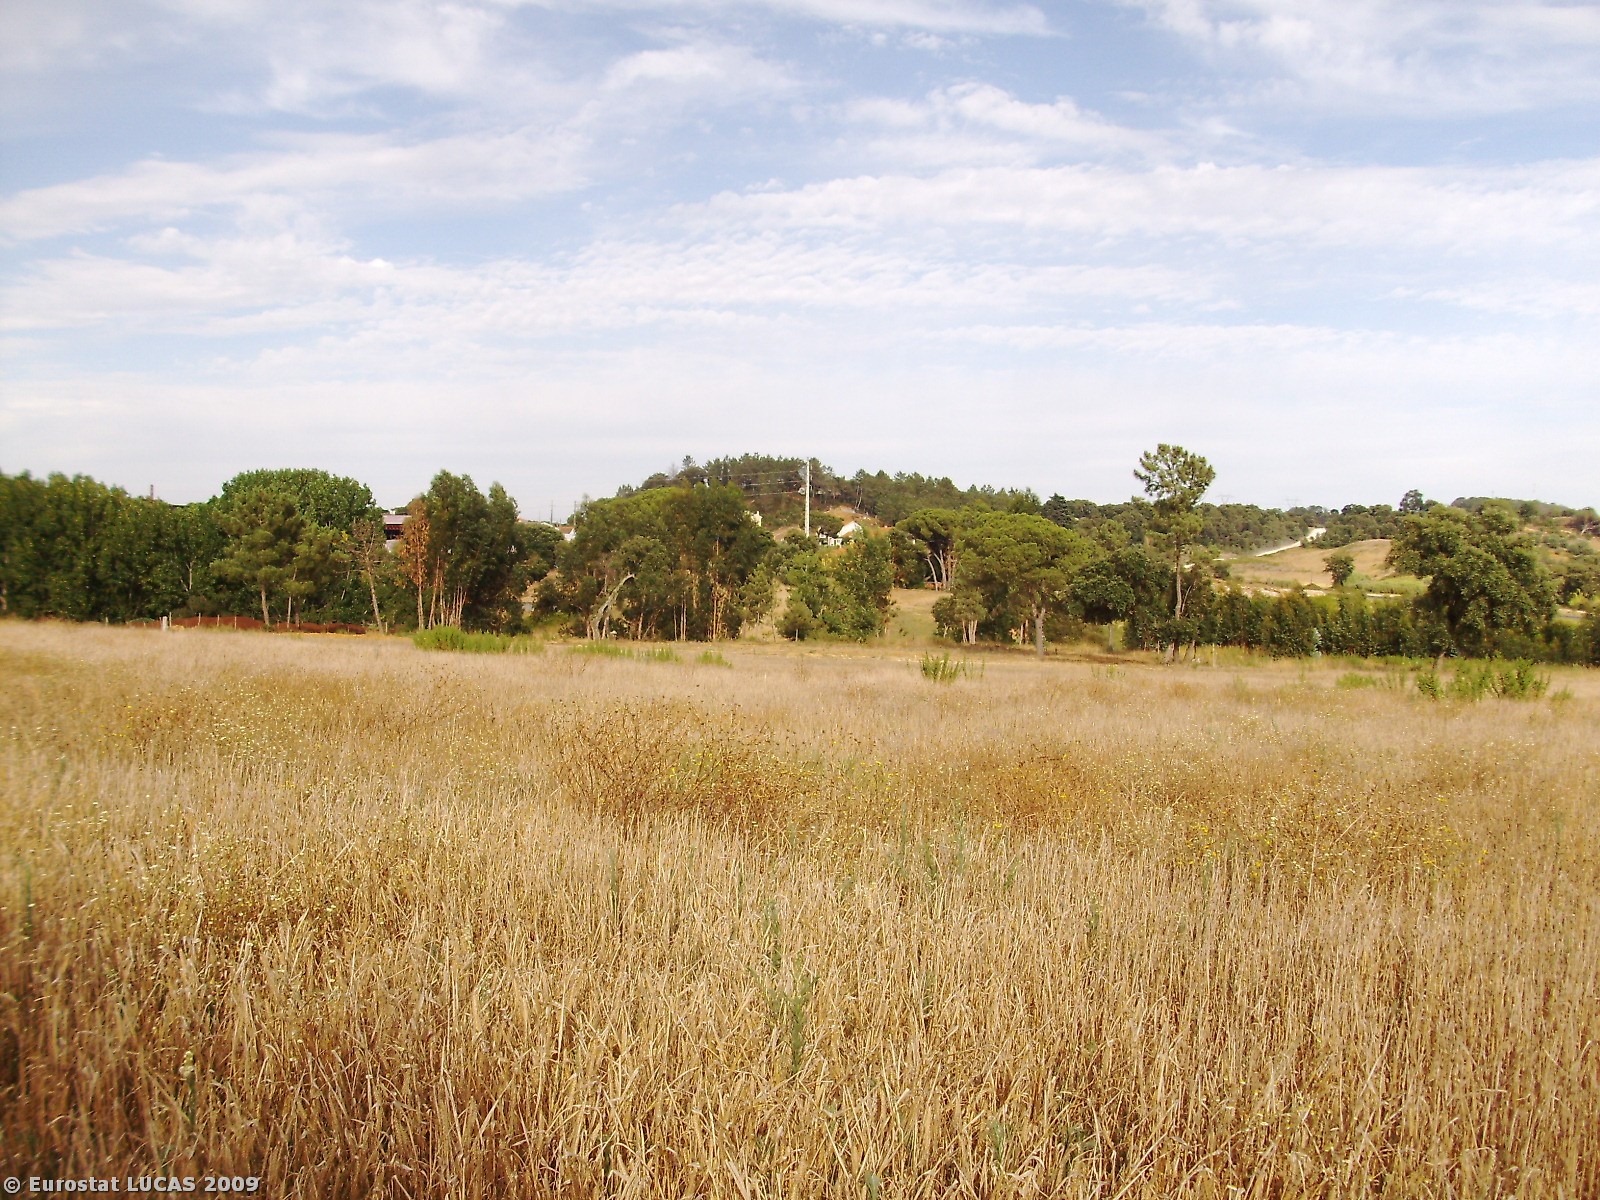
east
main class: Cropland
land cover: Barley
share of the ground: > 75 %
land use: Agriculture (excluding fallow land and kitchen gardens)
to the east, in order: Barley; Tracks; Bare land; Single bushes/trees; Shrubland with sparse tree cover; Broadleaved woodland; Rivers and streams; Shrubland with sparse tree cover; Spontaneously vegetated surfaces
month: July
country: PT
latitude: 39.3621
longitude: -8.7749
